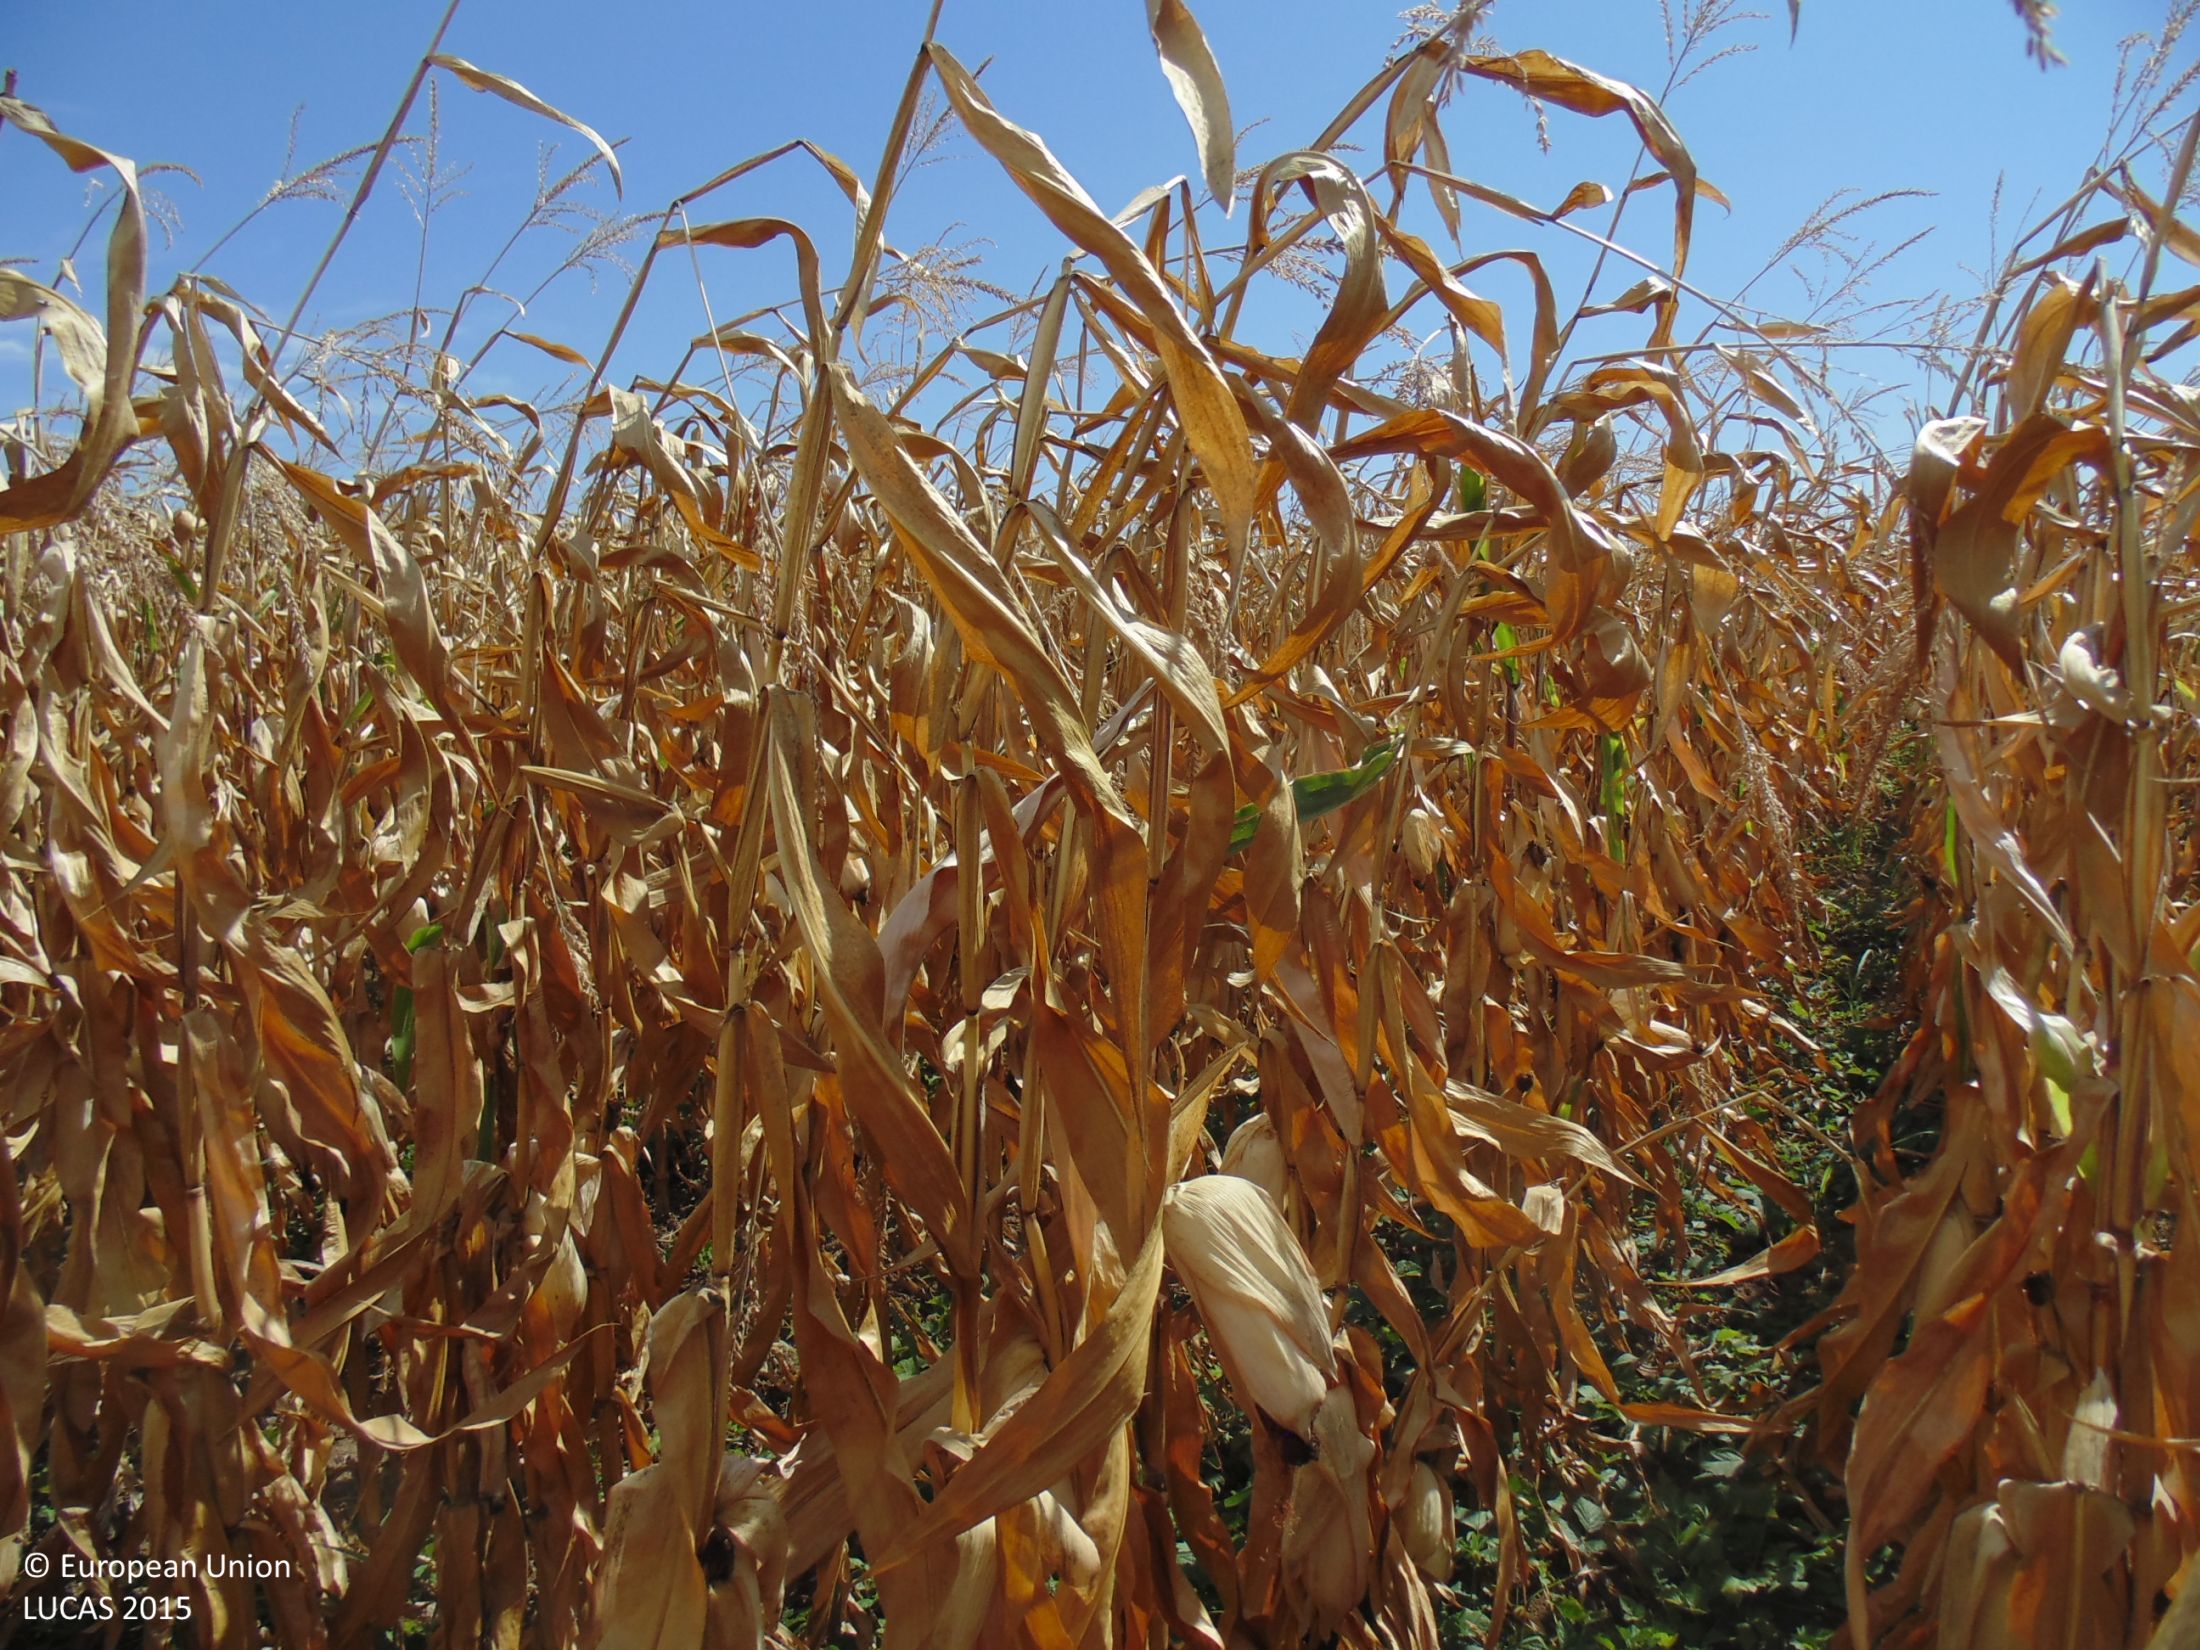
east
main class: Cropland
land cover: Maize
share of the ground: > 75 %
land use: Agriculture (excluding fallow land and kitchen gardens)
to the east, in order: Maize; Grass margins; Maize; Tracks
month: September
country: BG
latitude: 43.9125
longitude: 27.0978
